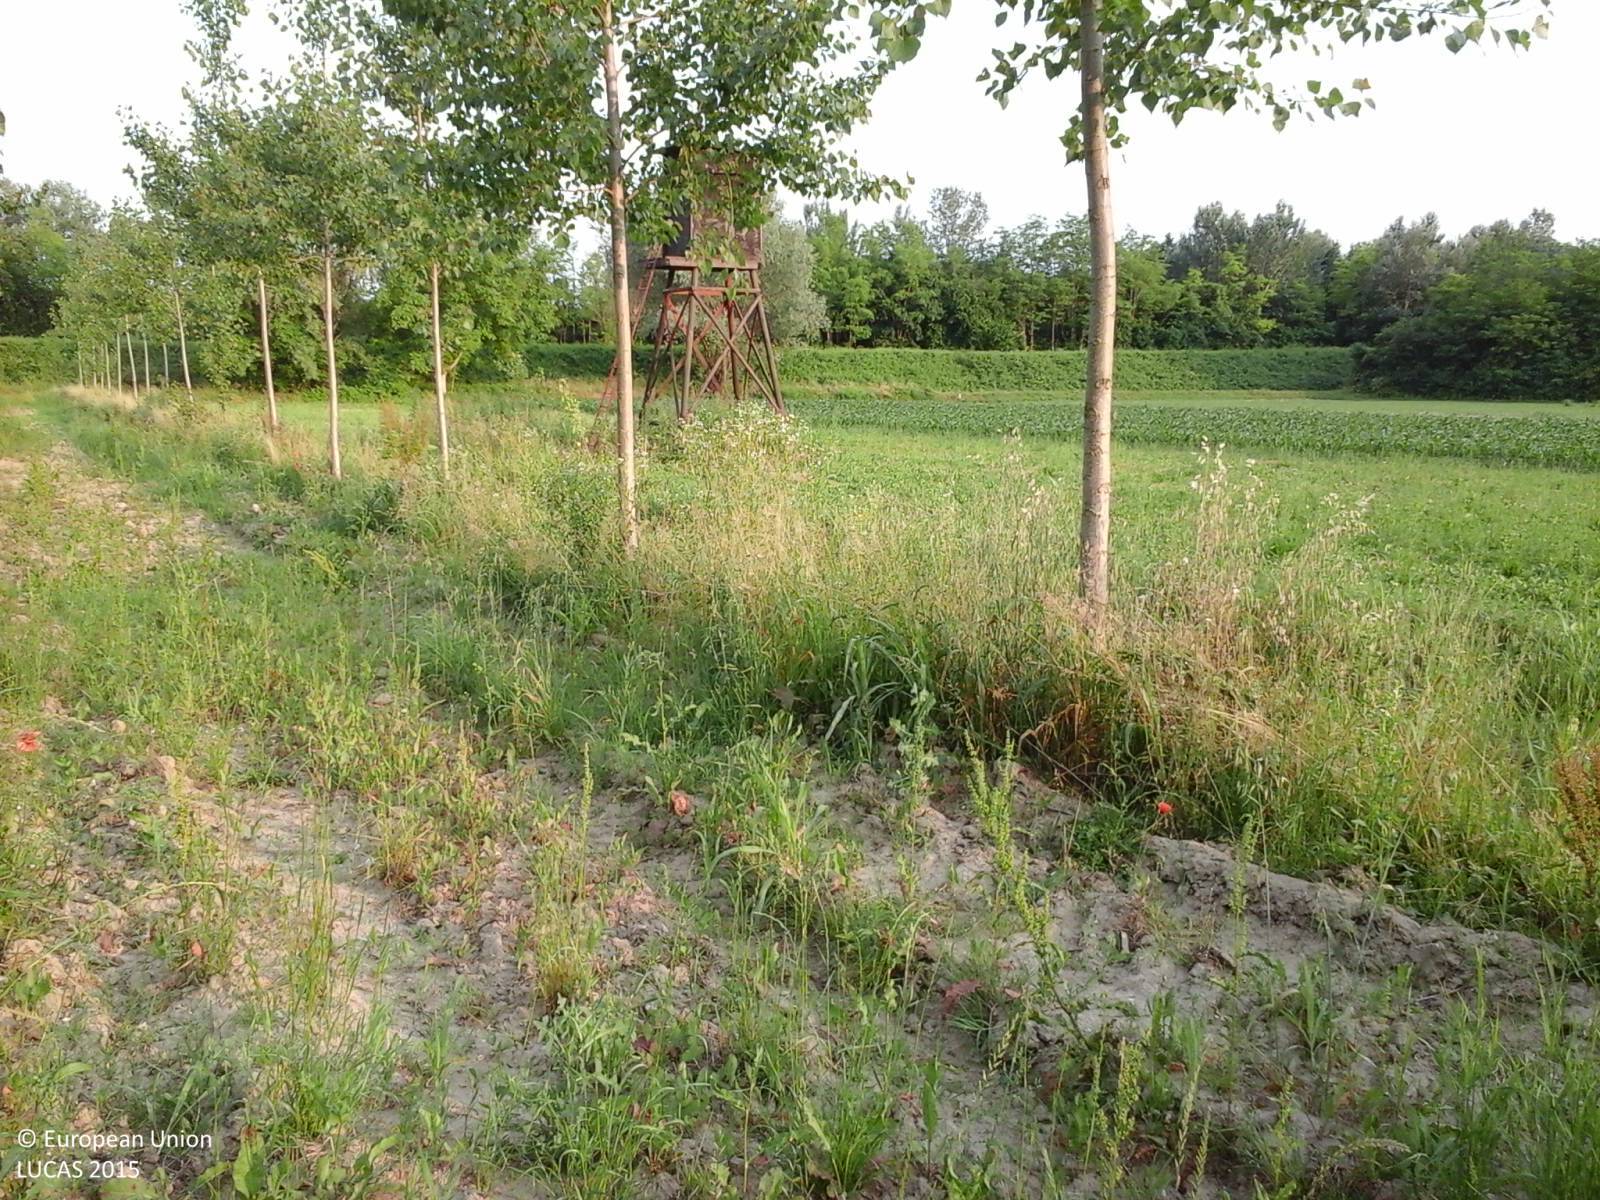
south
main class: Woodland
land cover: Broadleaved woodland
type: non-riverine alder, birch or aspen forest
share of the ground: > 75 %
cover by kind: broadleaved forest trees 70 %, herbaceous plants 20 %, unconsolidated bare surface 10 %
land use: Forestry
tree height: > 5 m
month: June
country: IT
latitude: 45.8454
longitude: 13.4341
